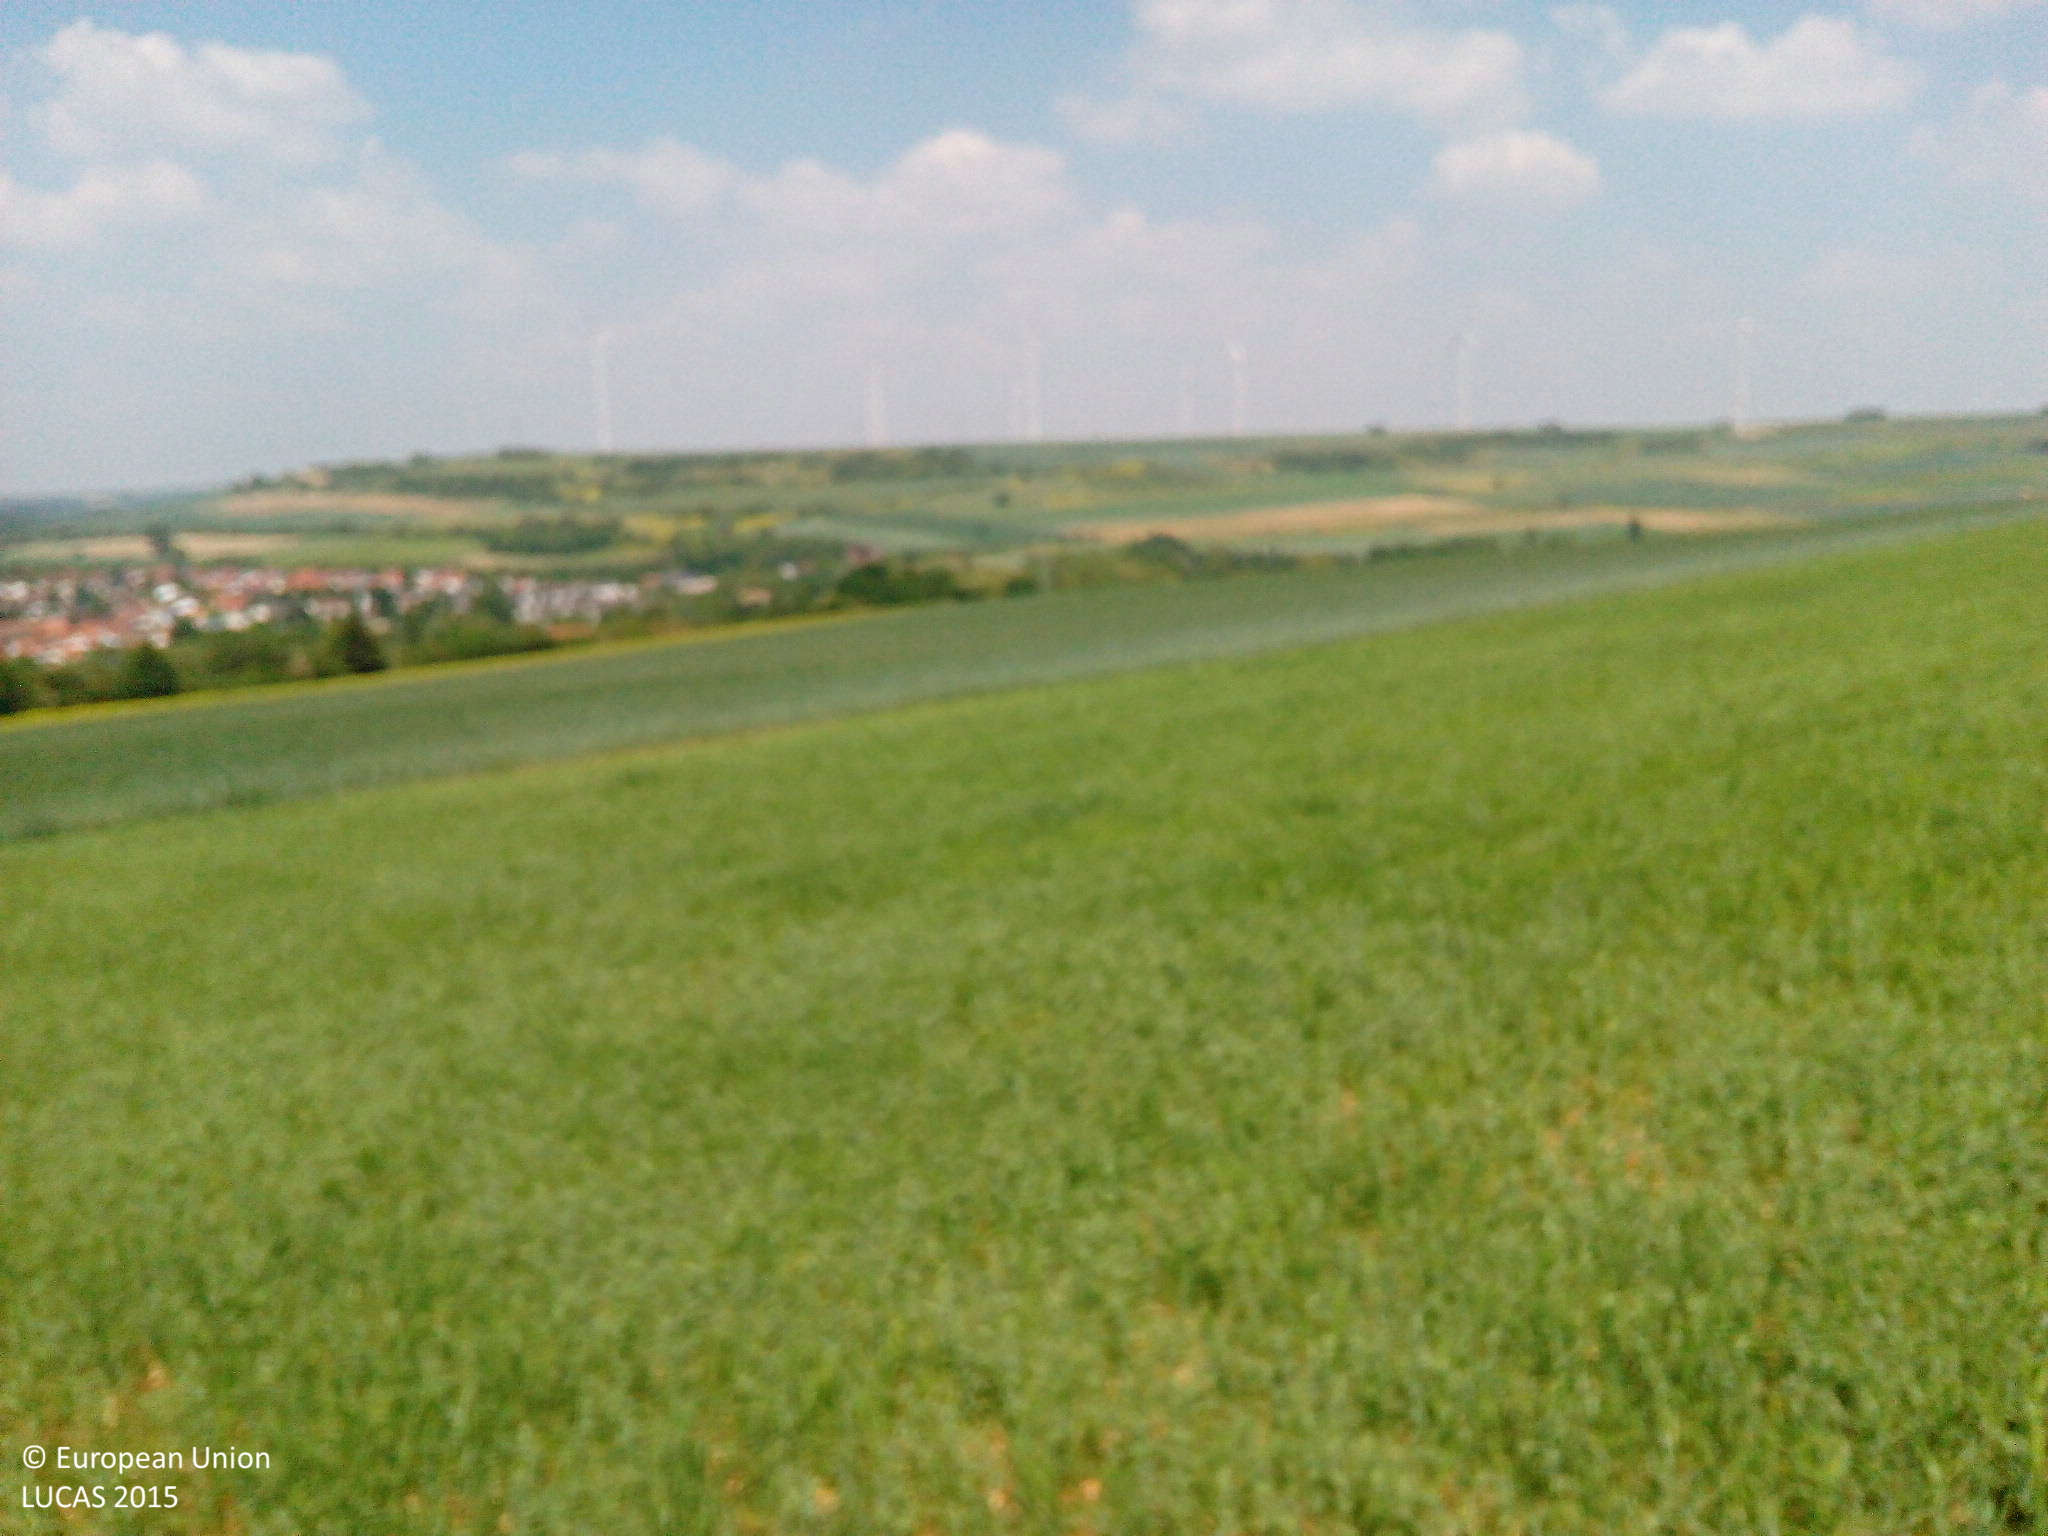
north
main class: Cropland
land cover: Other leguminous and mixtures for fodder
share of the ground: 50 - 75 %
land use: Agriculture (excluding fallow land and kitchen gardens)
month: May
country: DE
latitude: 49.6279
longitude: 8.0484
